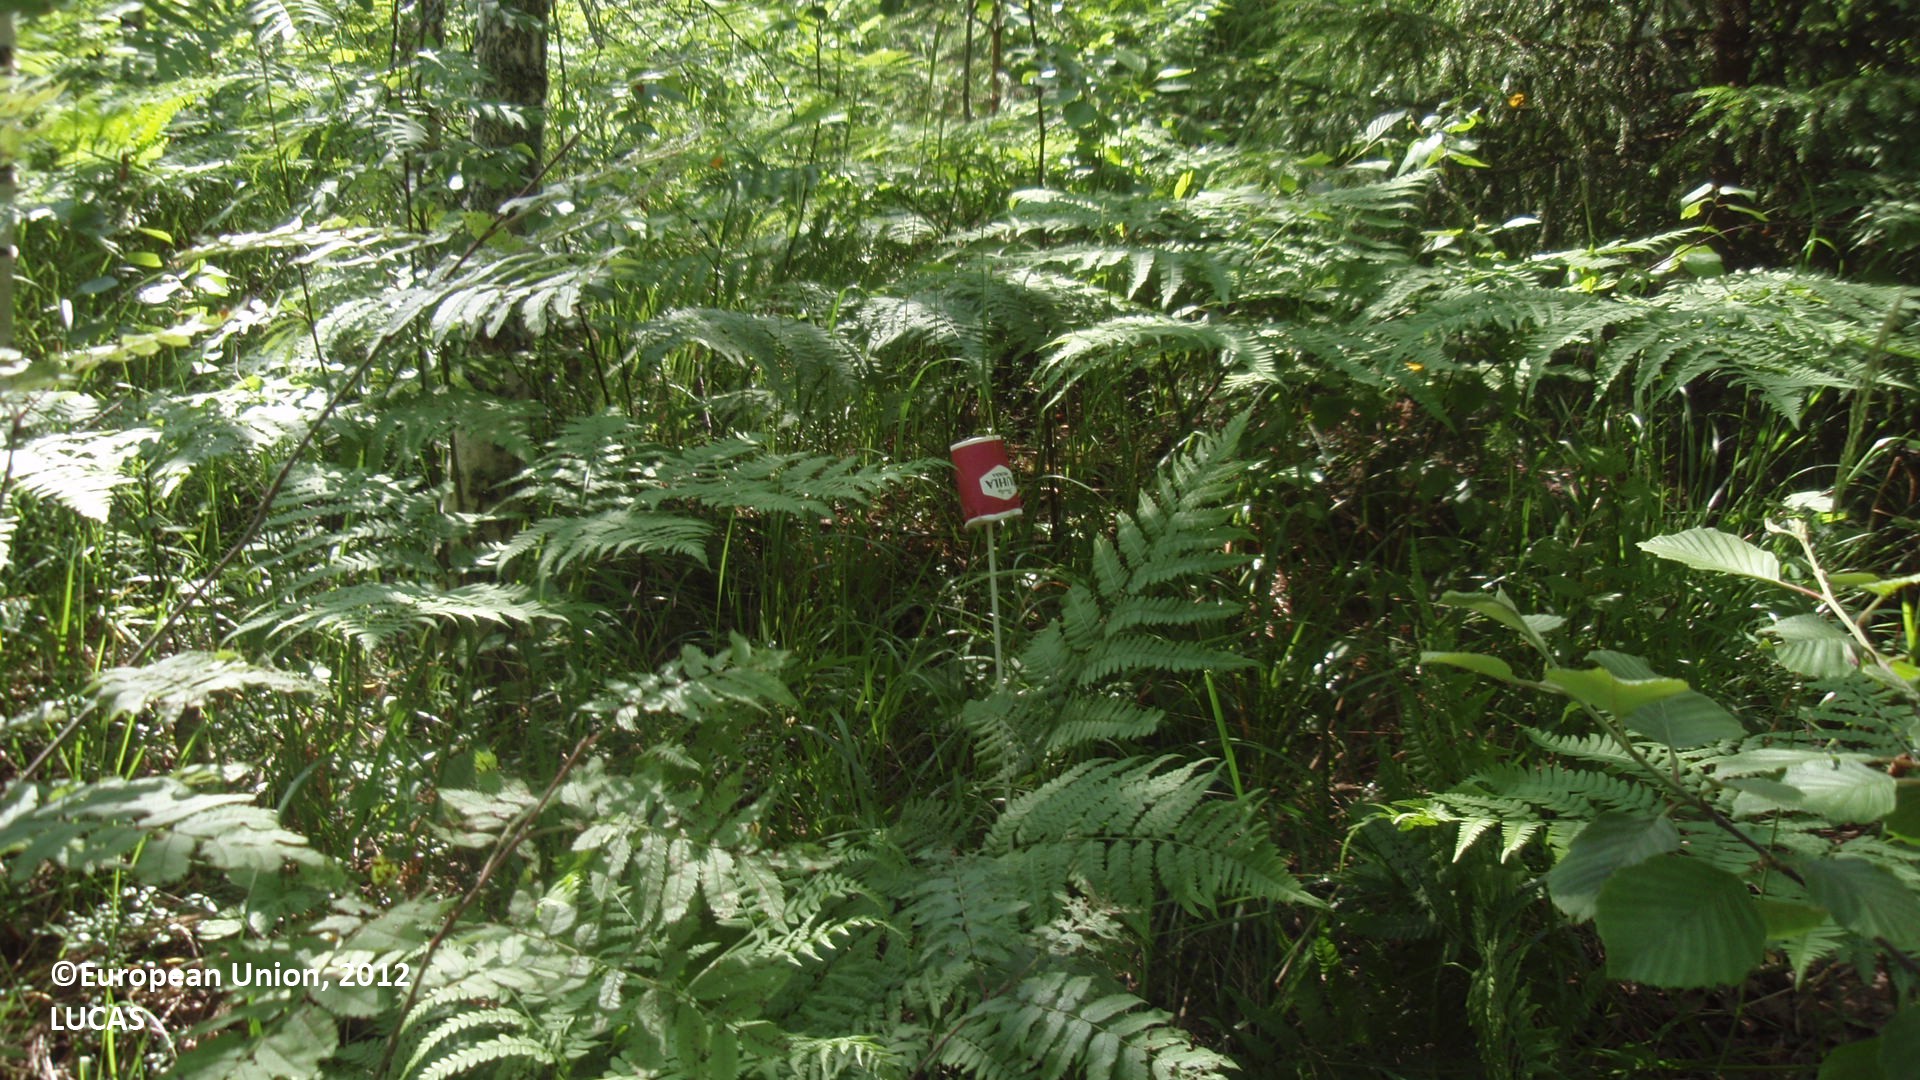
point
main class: Woodland
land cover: Broadleaved woodland
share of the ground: 50 - 75 %
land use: Forestry
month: July
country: FI
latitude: 61.5845
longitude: 29.1684
